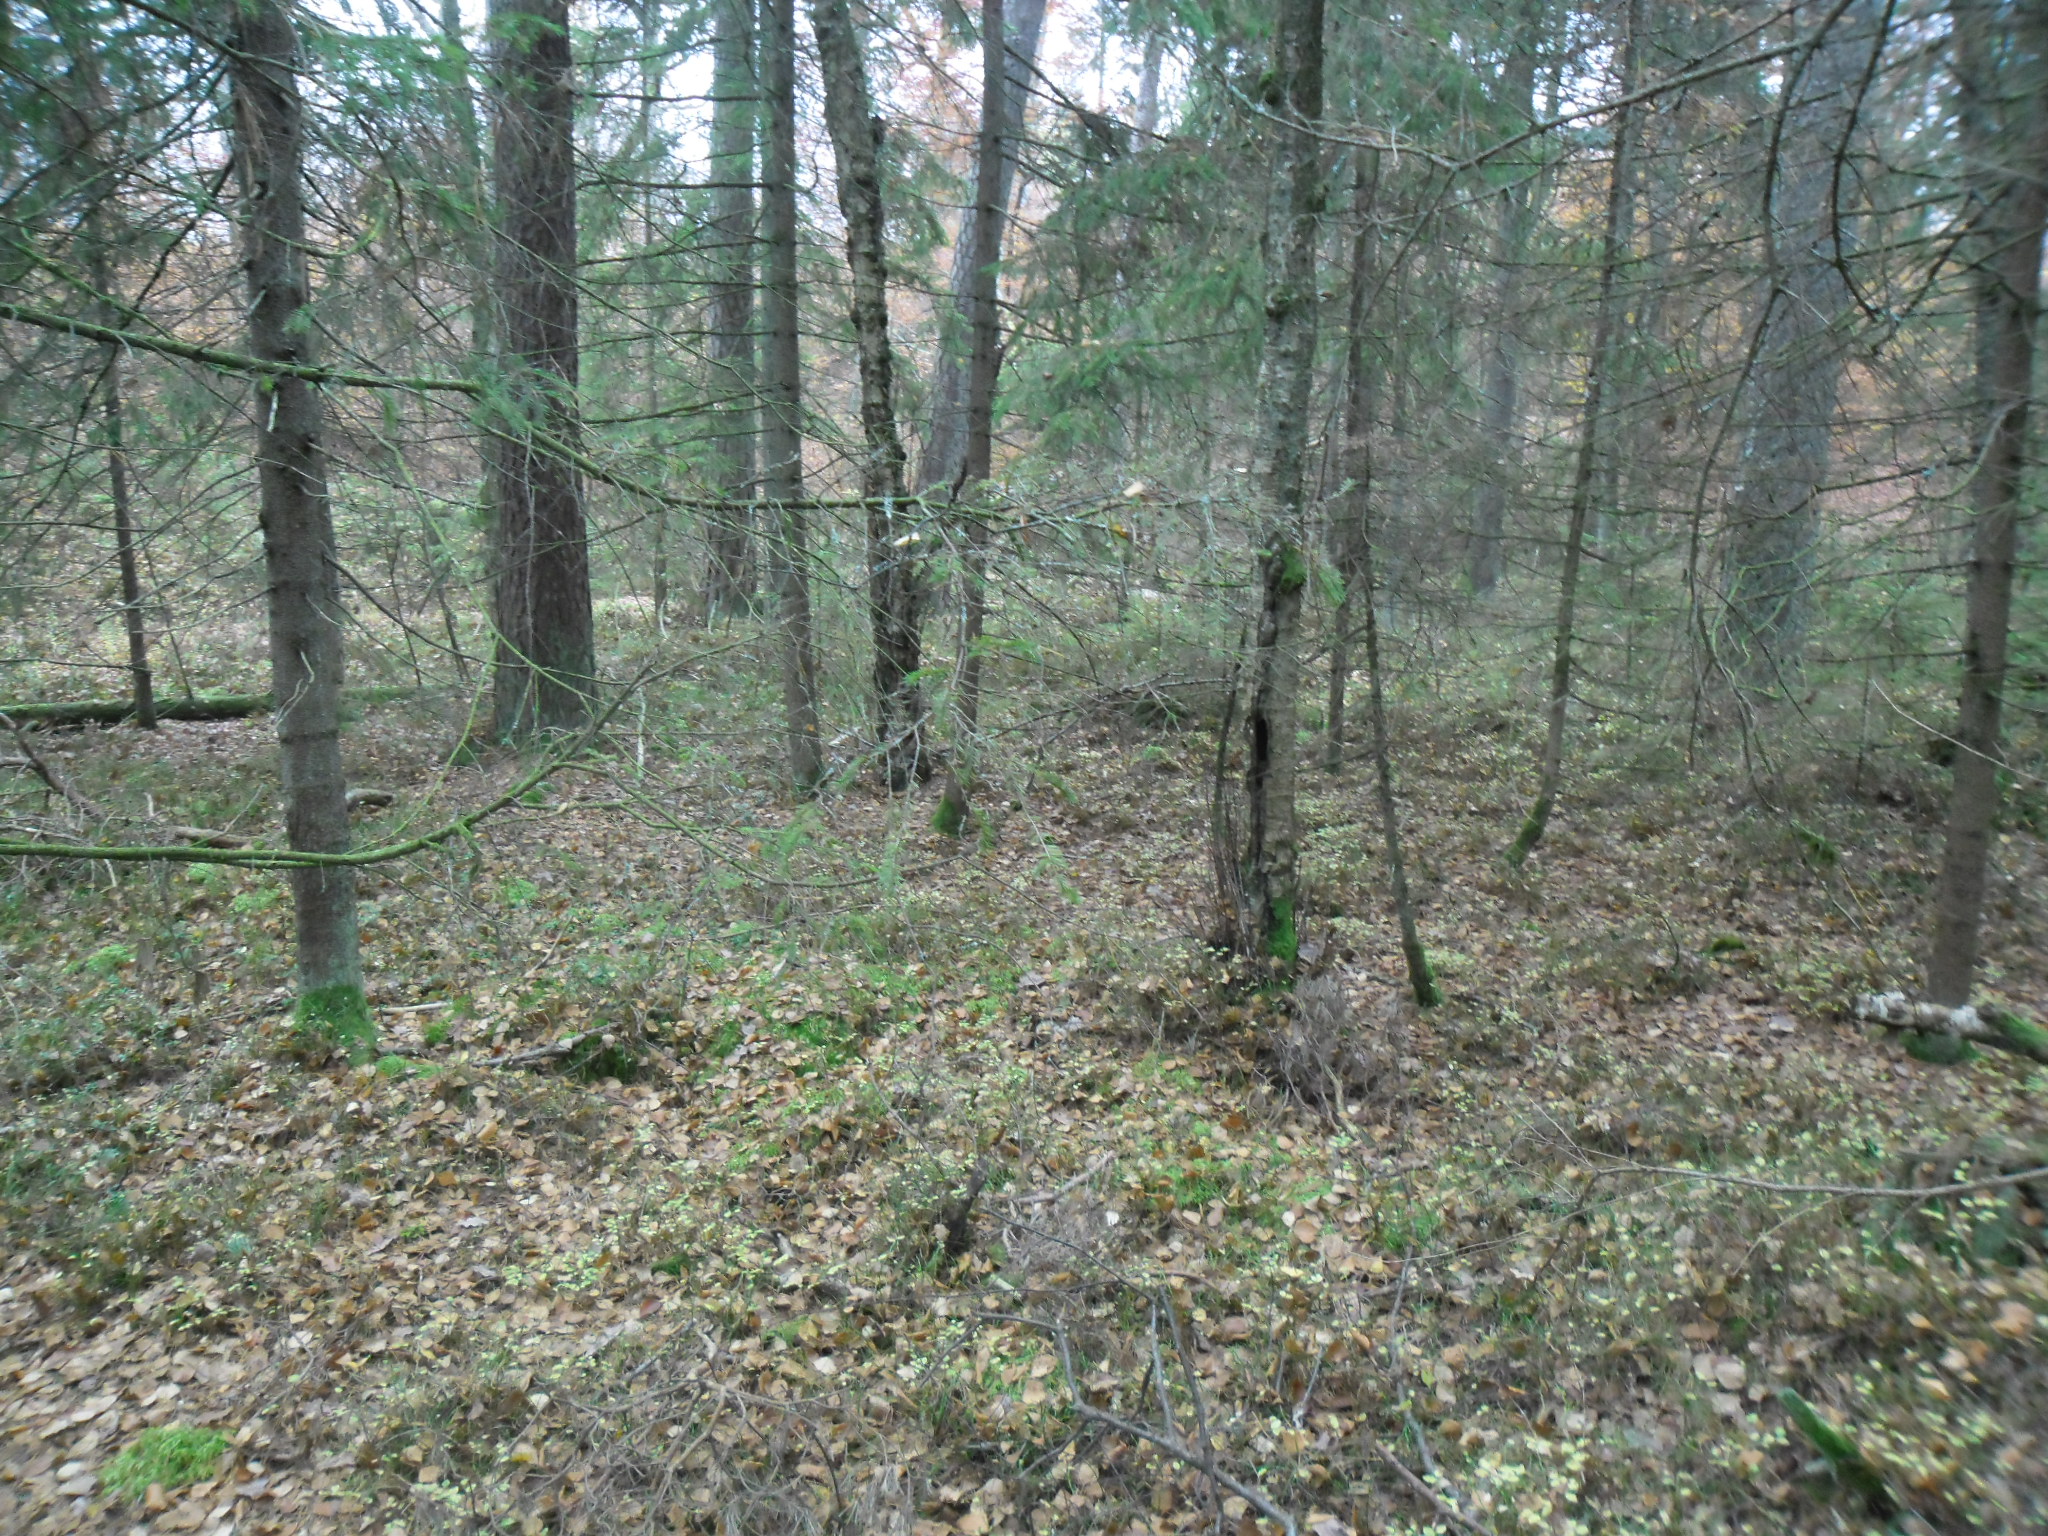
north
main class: Woodland
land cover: Pine dominated mixed woodland
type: boreal forest
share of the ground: > 75 %
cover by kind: coniferous forest trees 60 %, broadleaved forest trees 20 %, shrubs 20 %
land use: Forestry
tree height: > 5 m
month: November
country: SE
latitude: 56.3126
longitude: 13.0849
